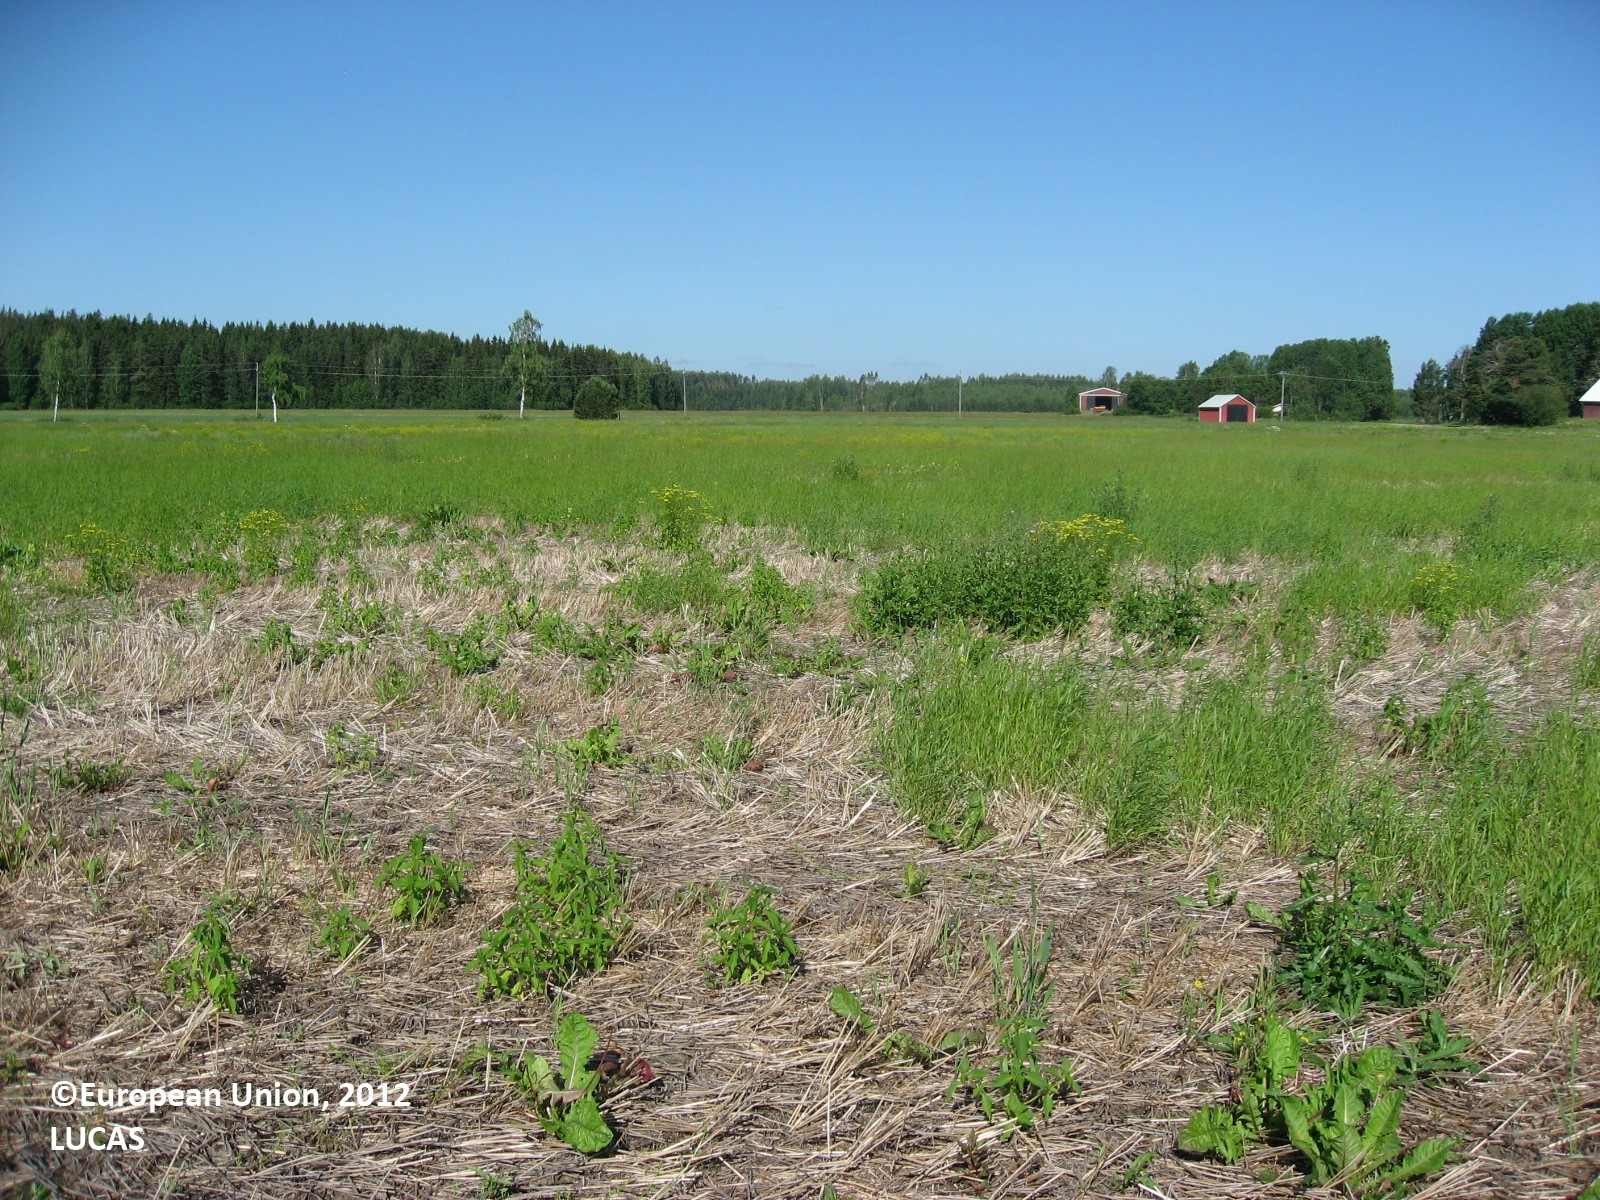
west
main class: Grassland
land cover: Spontaneously vegetated surfaces
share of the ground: 50 - 75 %
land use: Fallow land
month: July
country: FI
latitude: 60.8478
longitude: 26.2865
